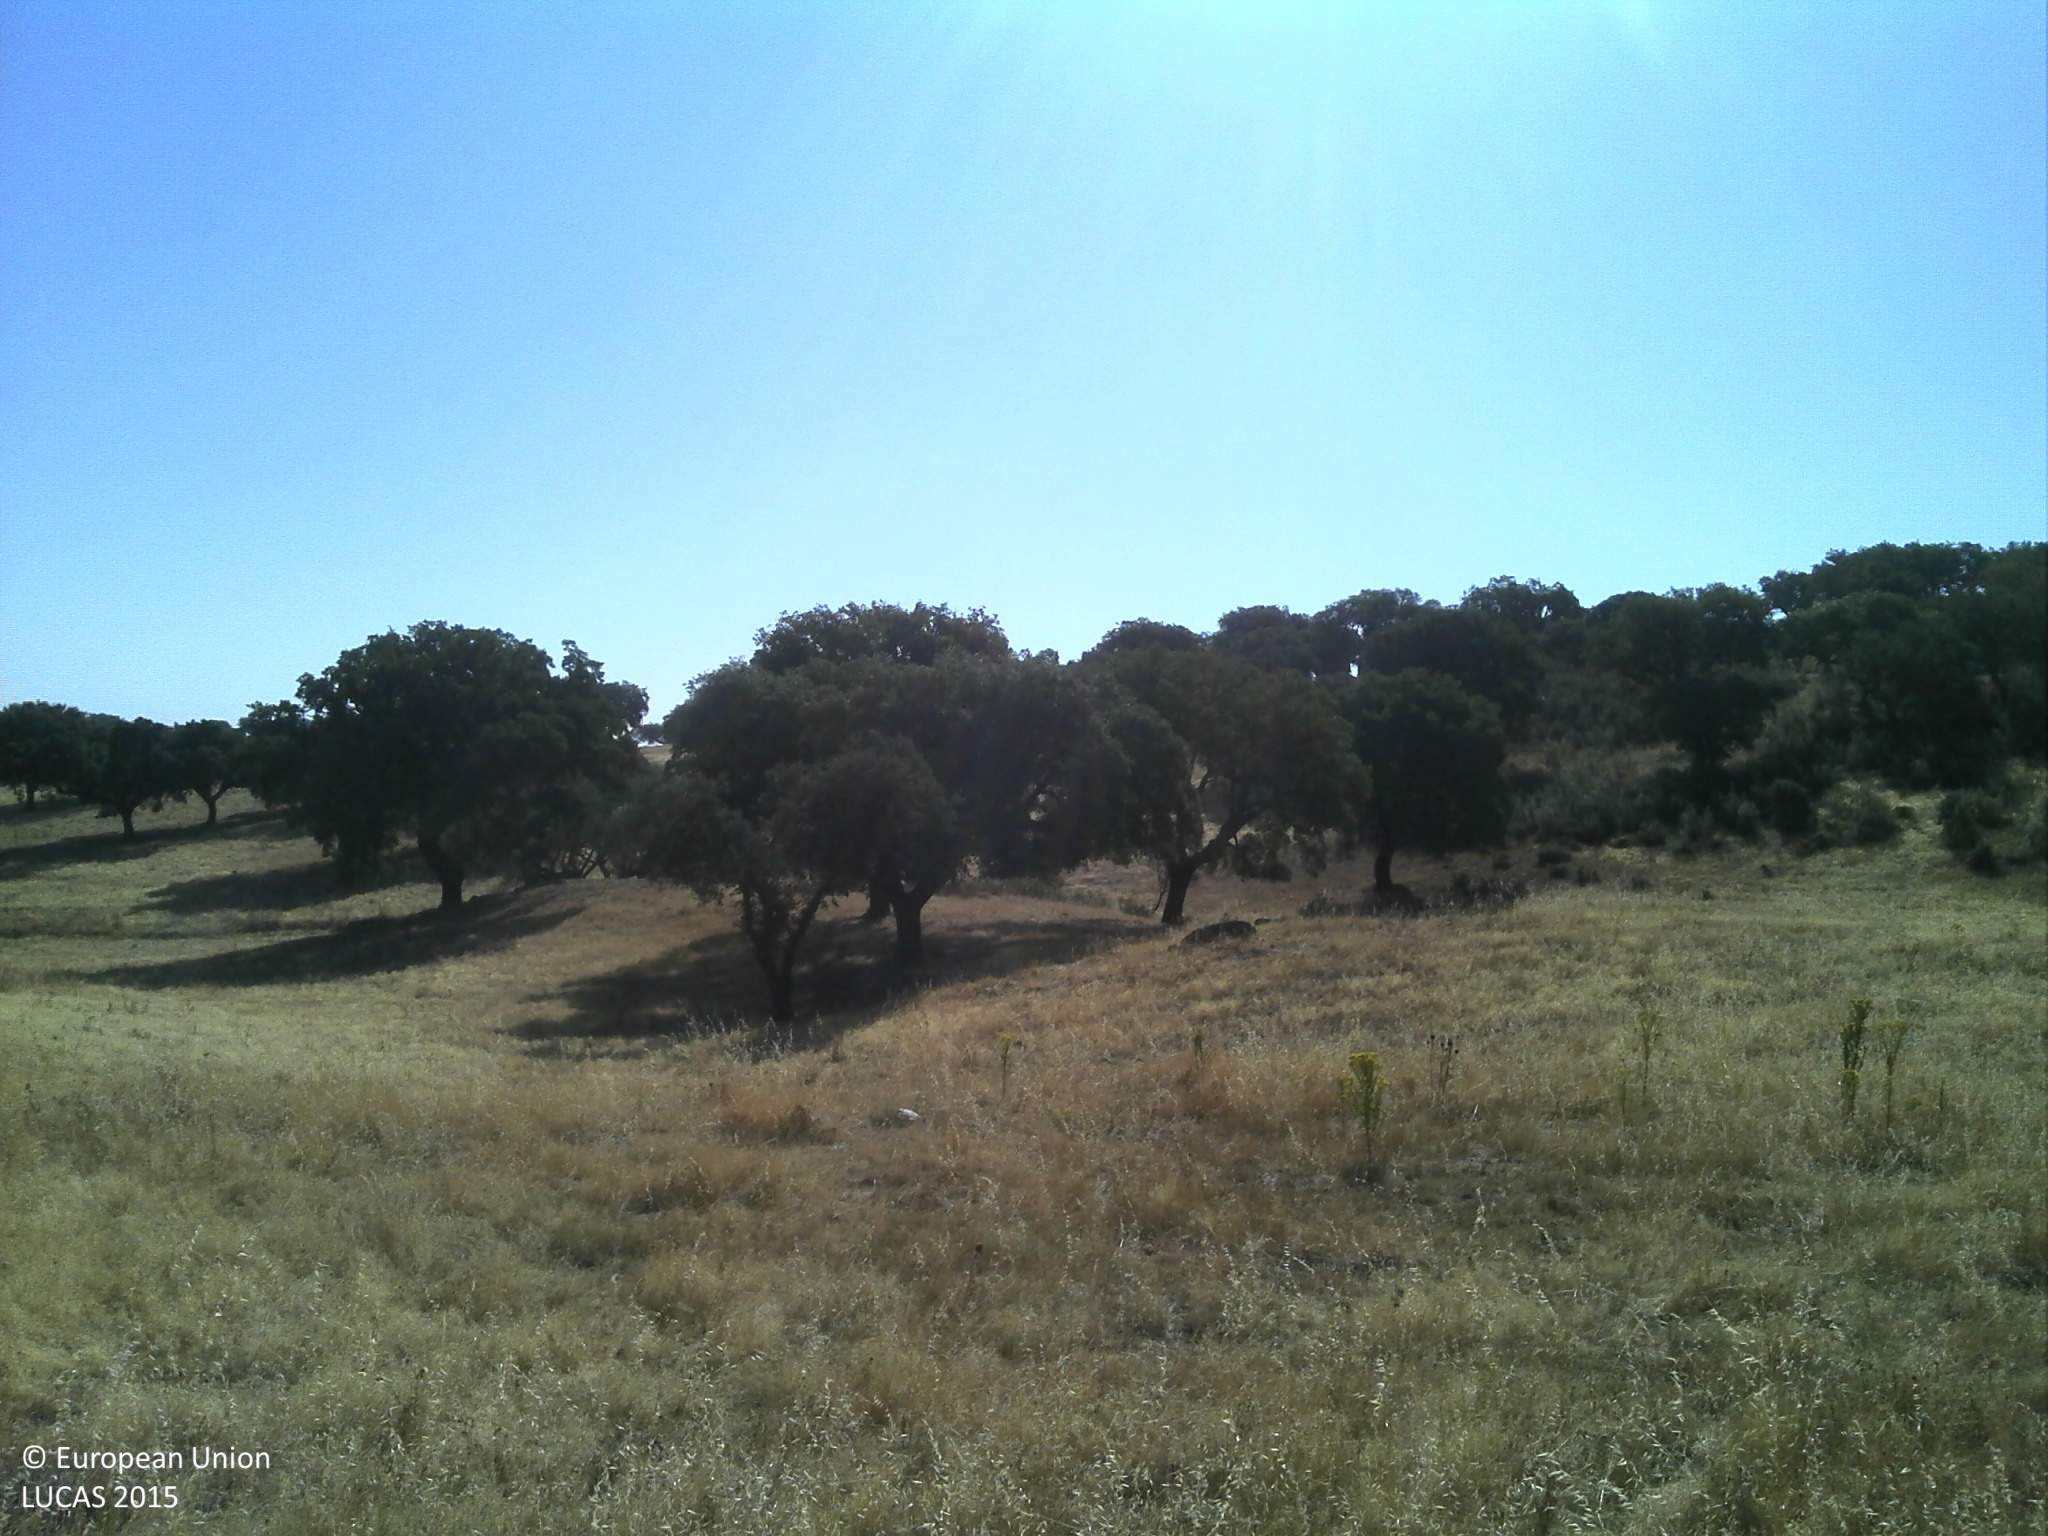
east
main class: Grassland
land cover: Grassland without tree/shrub cover
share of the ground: 50 - 75 %
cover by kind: herbaceous plants 75 %, unconsolidated bare surface 25 %
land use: Agriculture (excluding fallow land and kitchen gardens)
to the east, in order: Grassland without tree/shrub cover; Broadleaved woodland; Rivers and streams; Grassland without tree/shrub cover; Broadleaved woodland
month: July
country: PT
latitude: 38.6443
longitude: -7.2951
